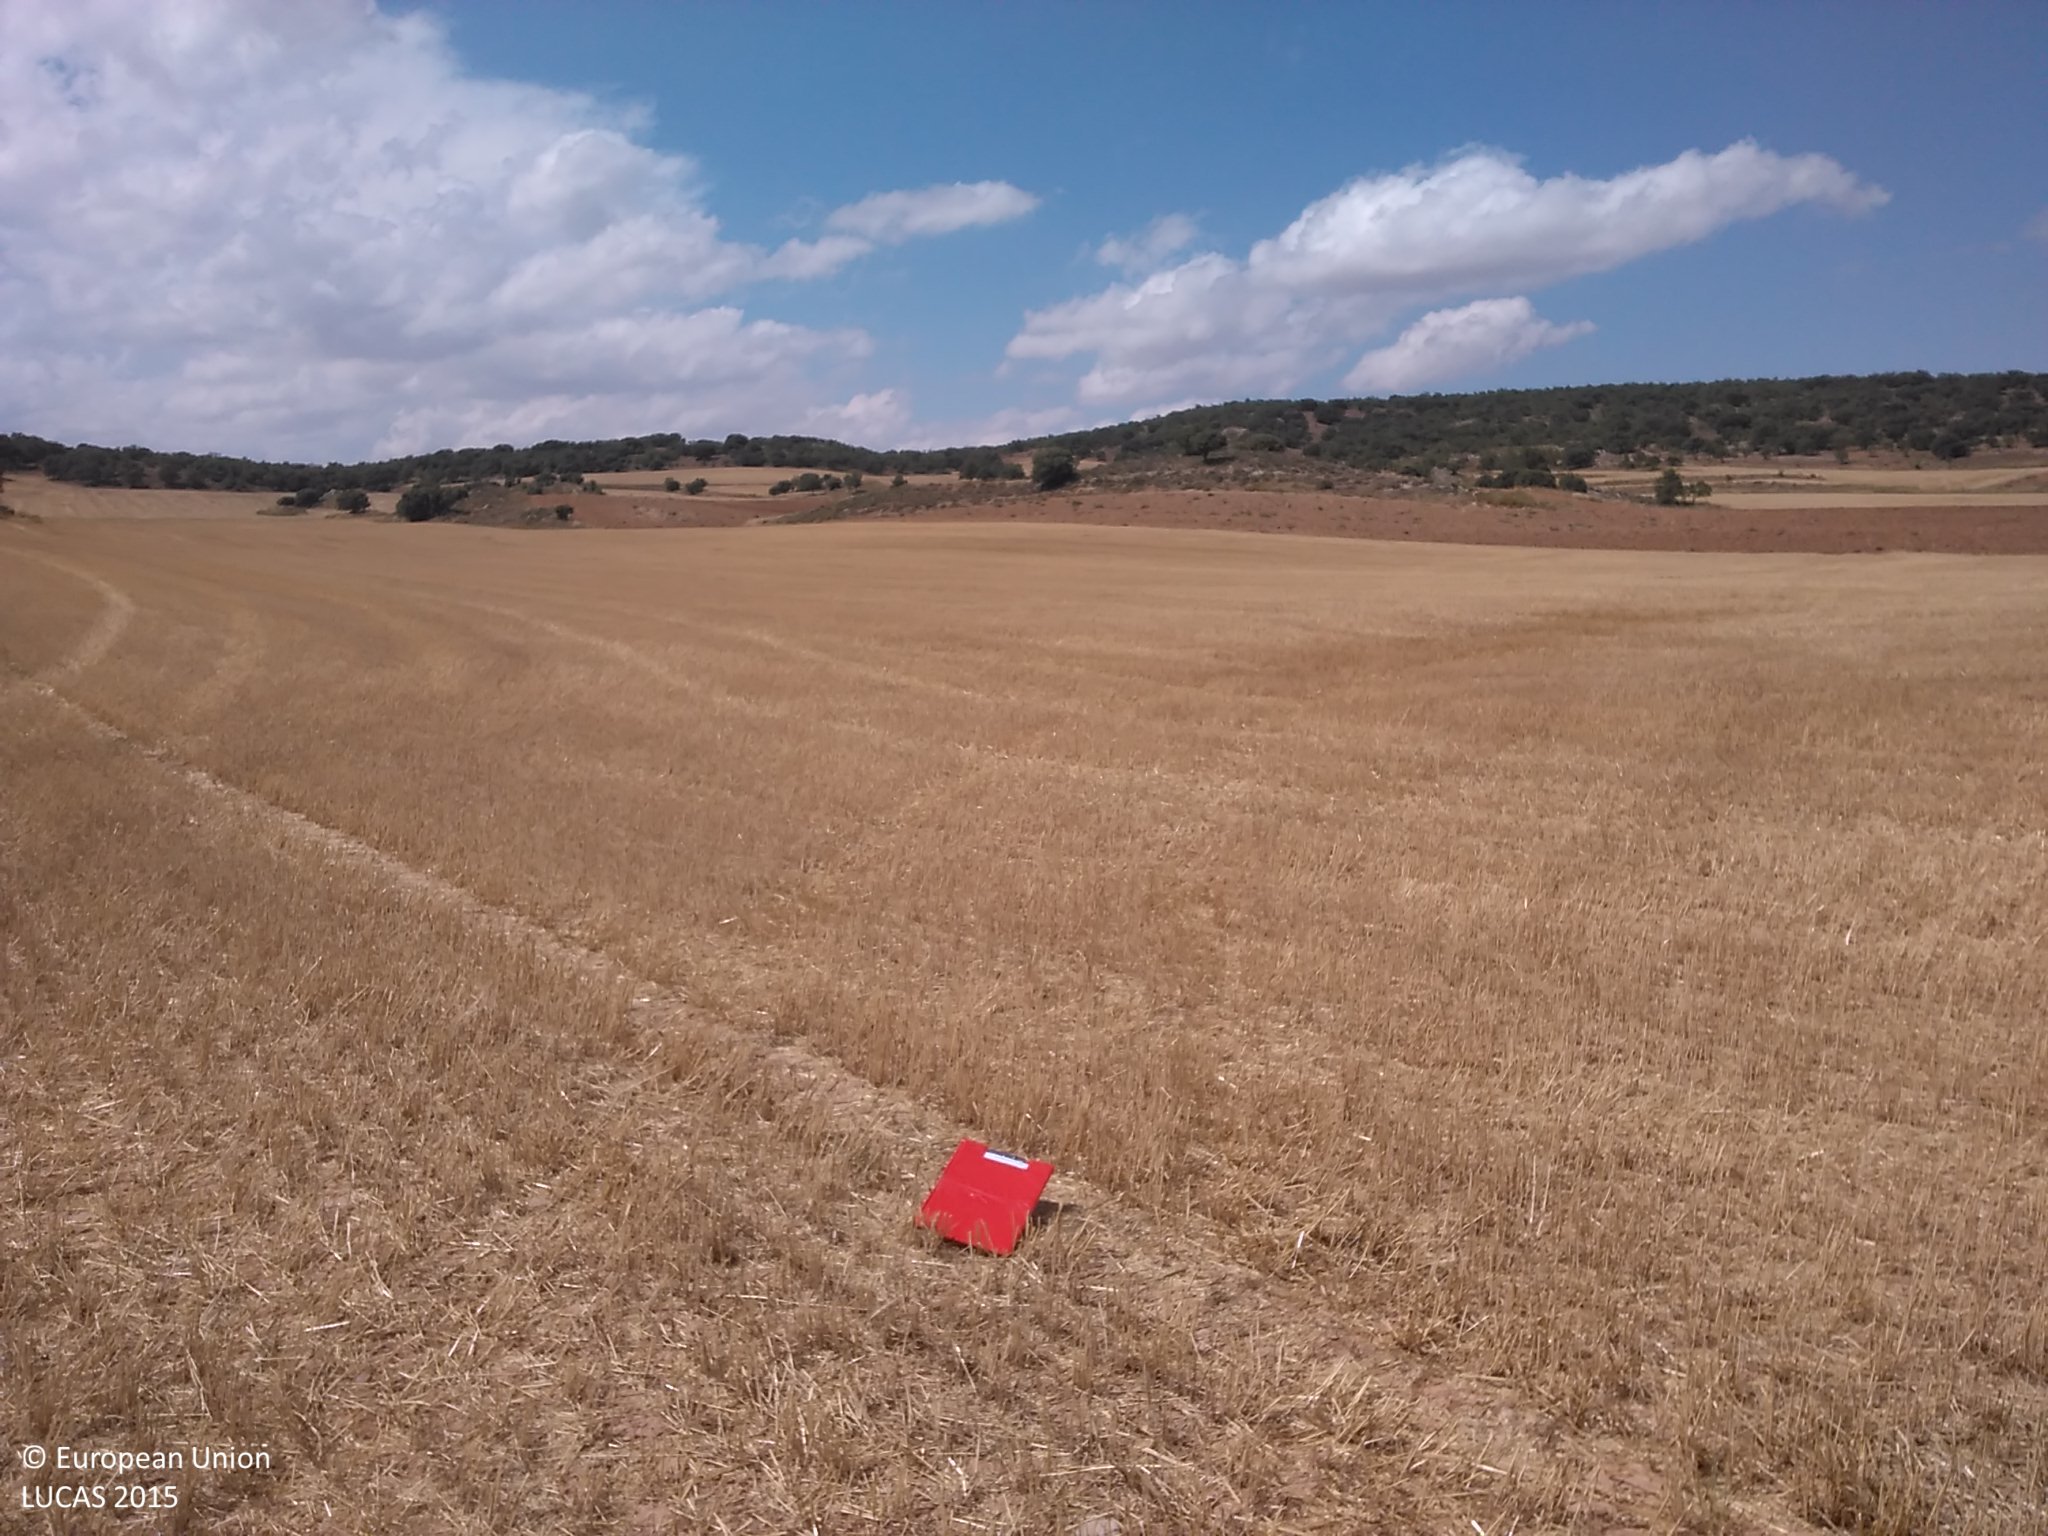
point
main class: Cropland
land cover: Common wheat
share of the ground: < 10 %
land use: Agriculture (excluding fallow land and kitchen gardens)
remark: Harvested field
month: July
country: ES
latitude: 41.5692
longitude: -2.1809
